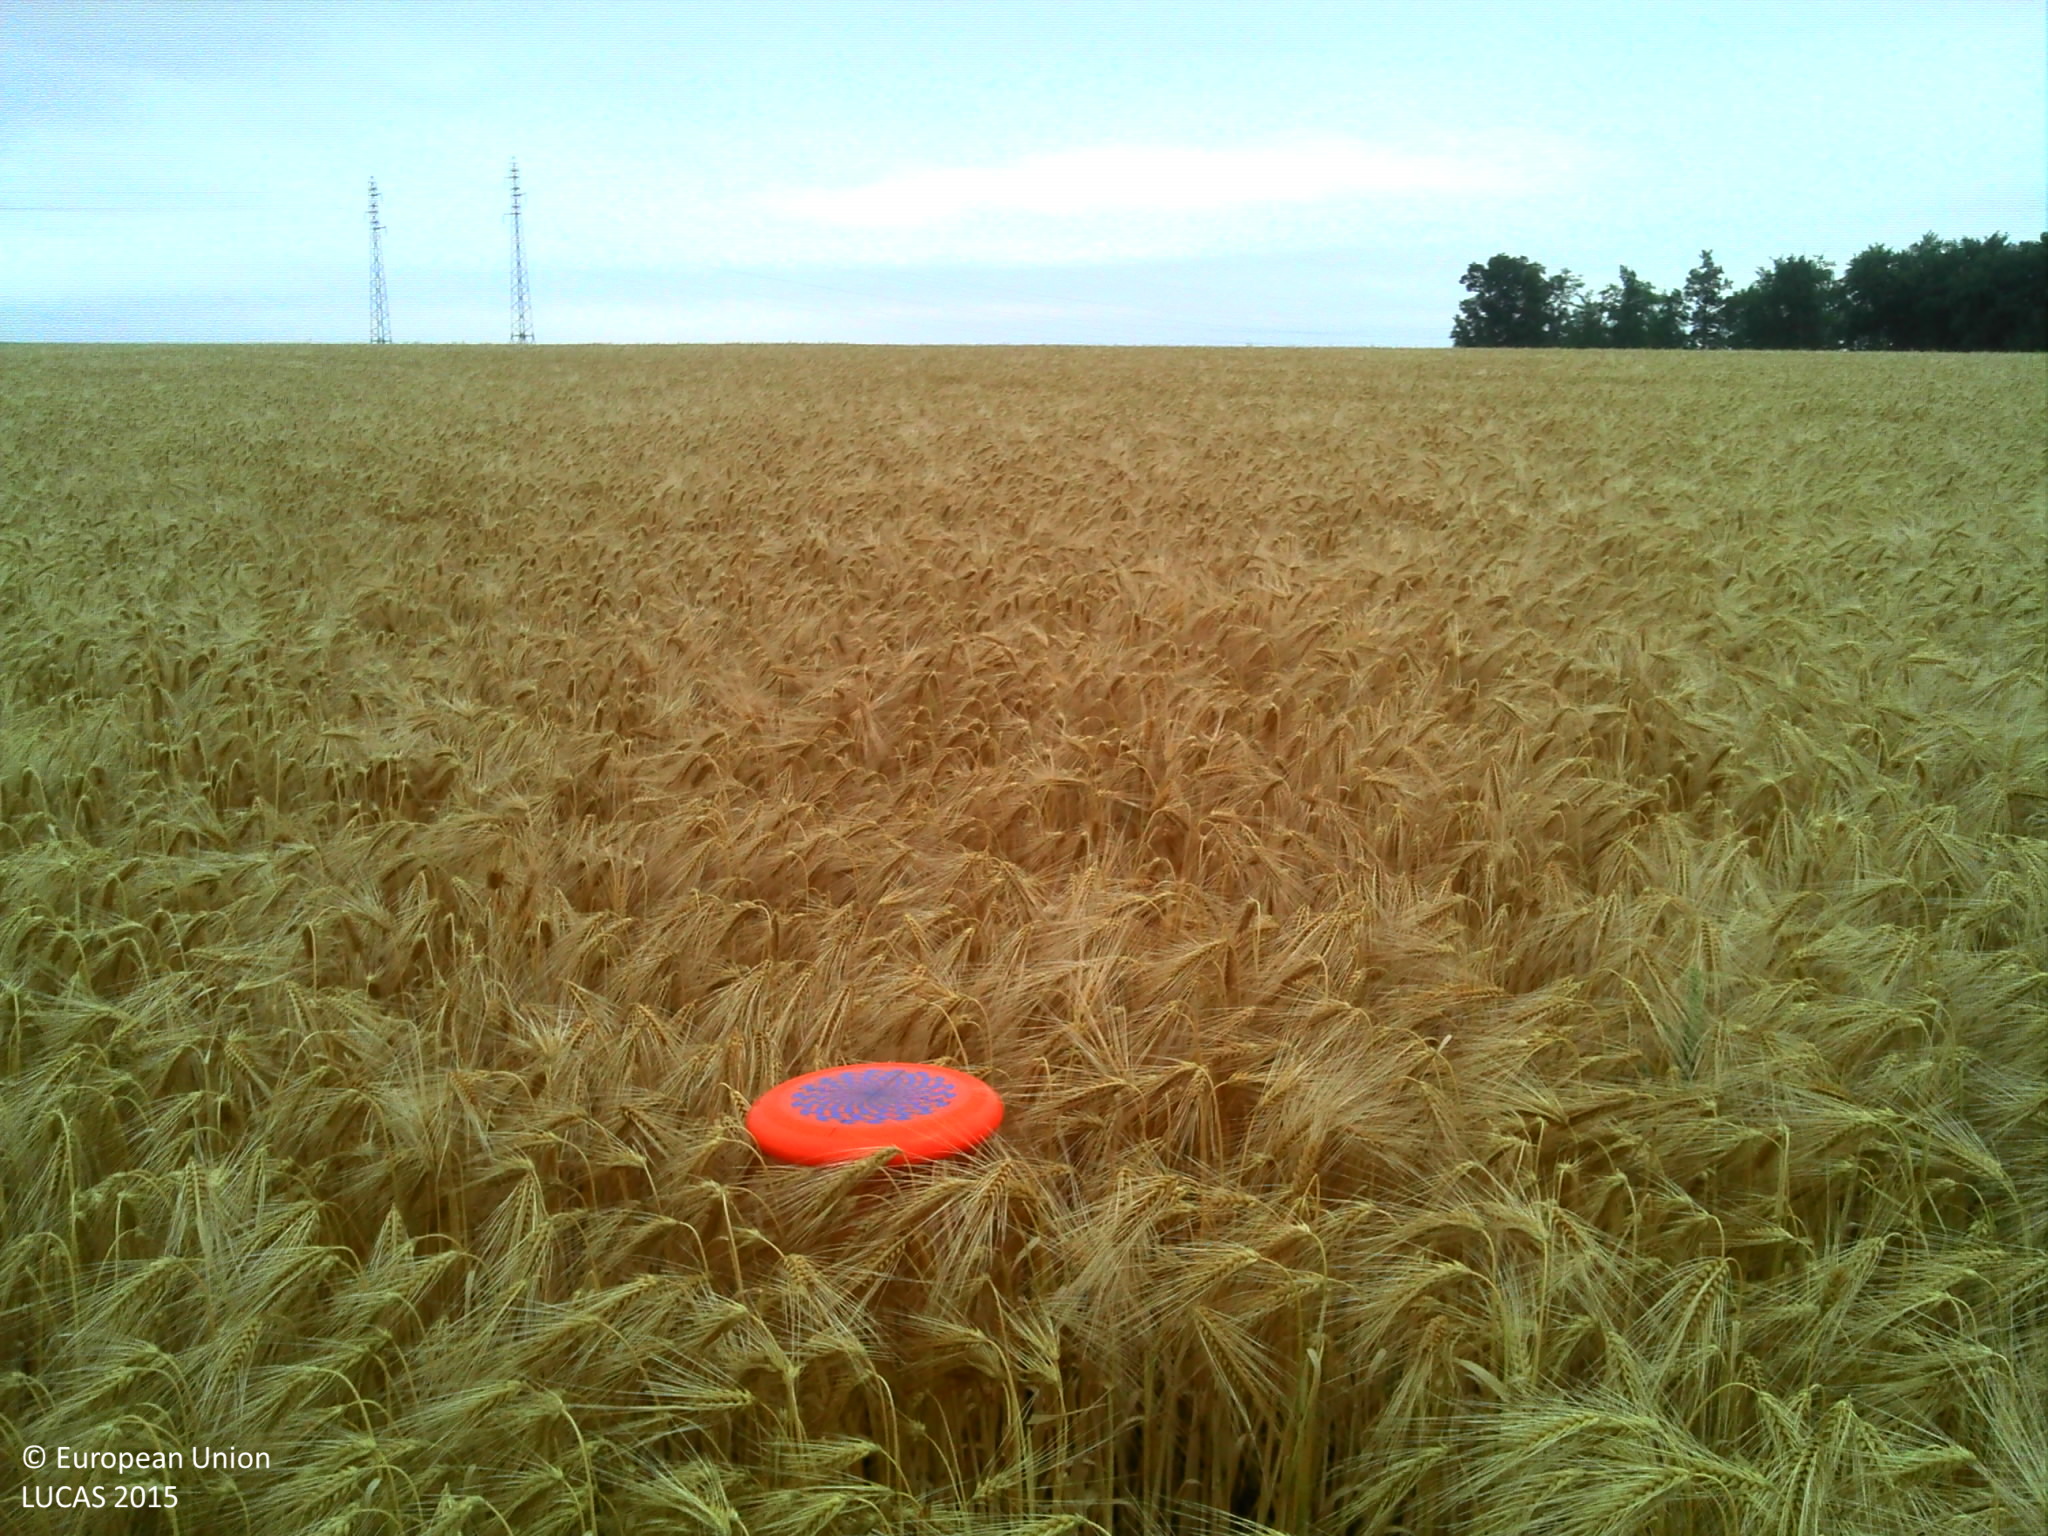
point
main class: Cropland
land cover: Barley
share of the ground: > 75 %
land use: Agriculture (excluding fallow land and kitchen gardens)
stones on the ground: 10 - 25 %
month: June
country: FR
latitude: 47.8749
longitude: 3.9132
